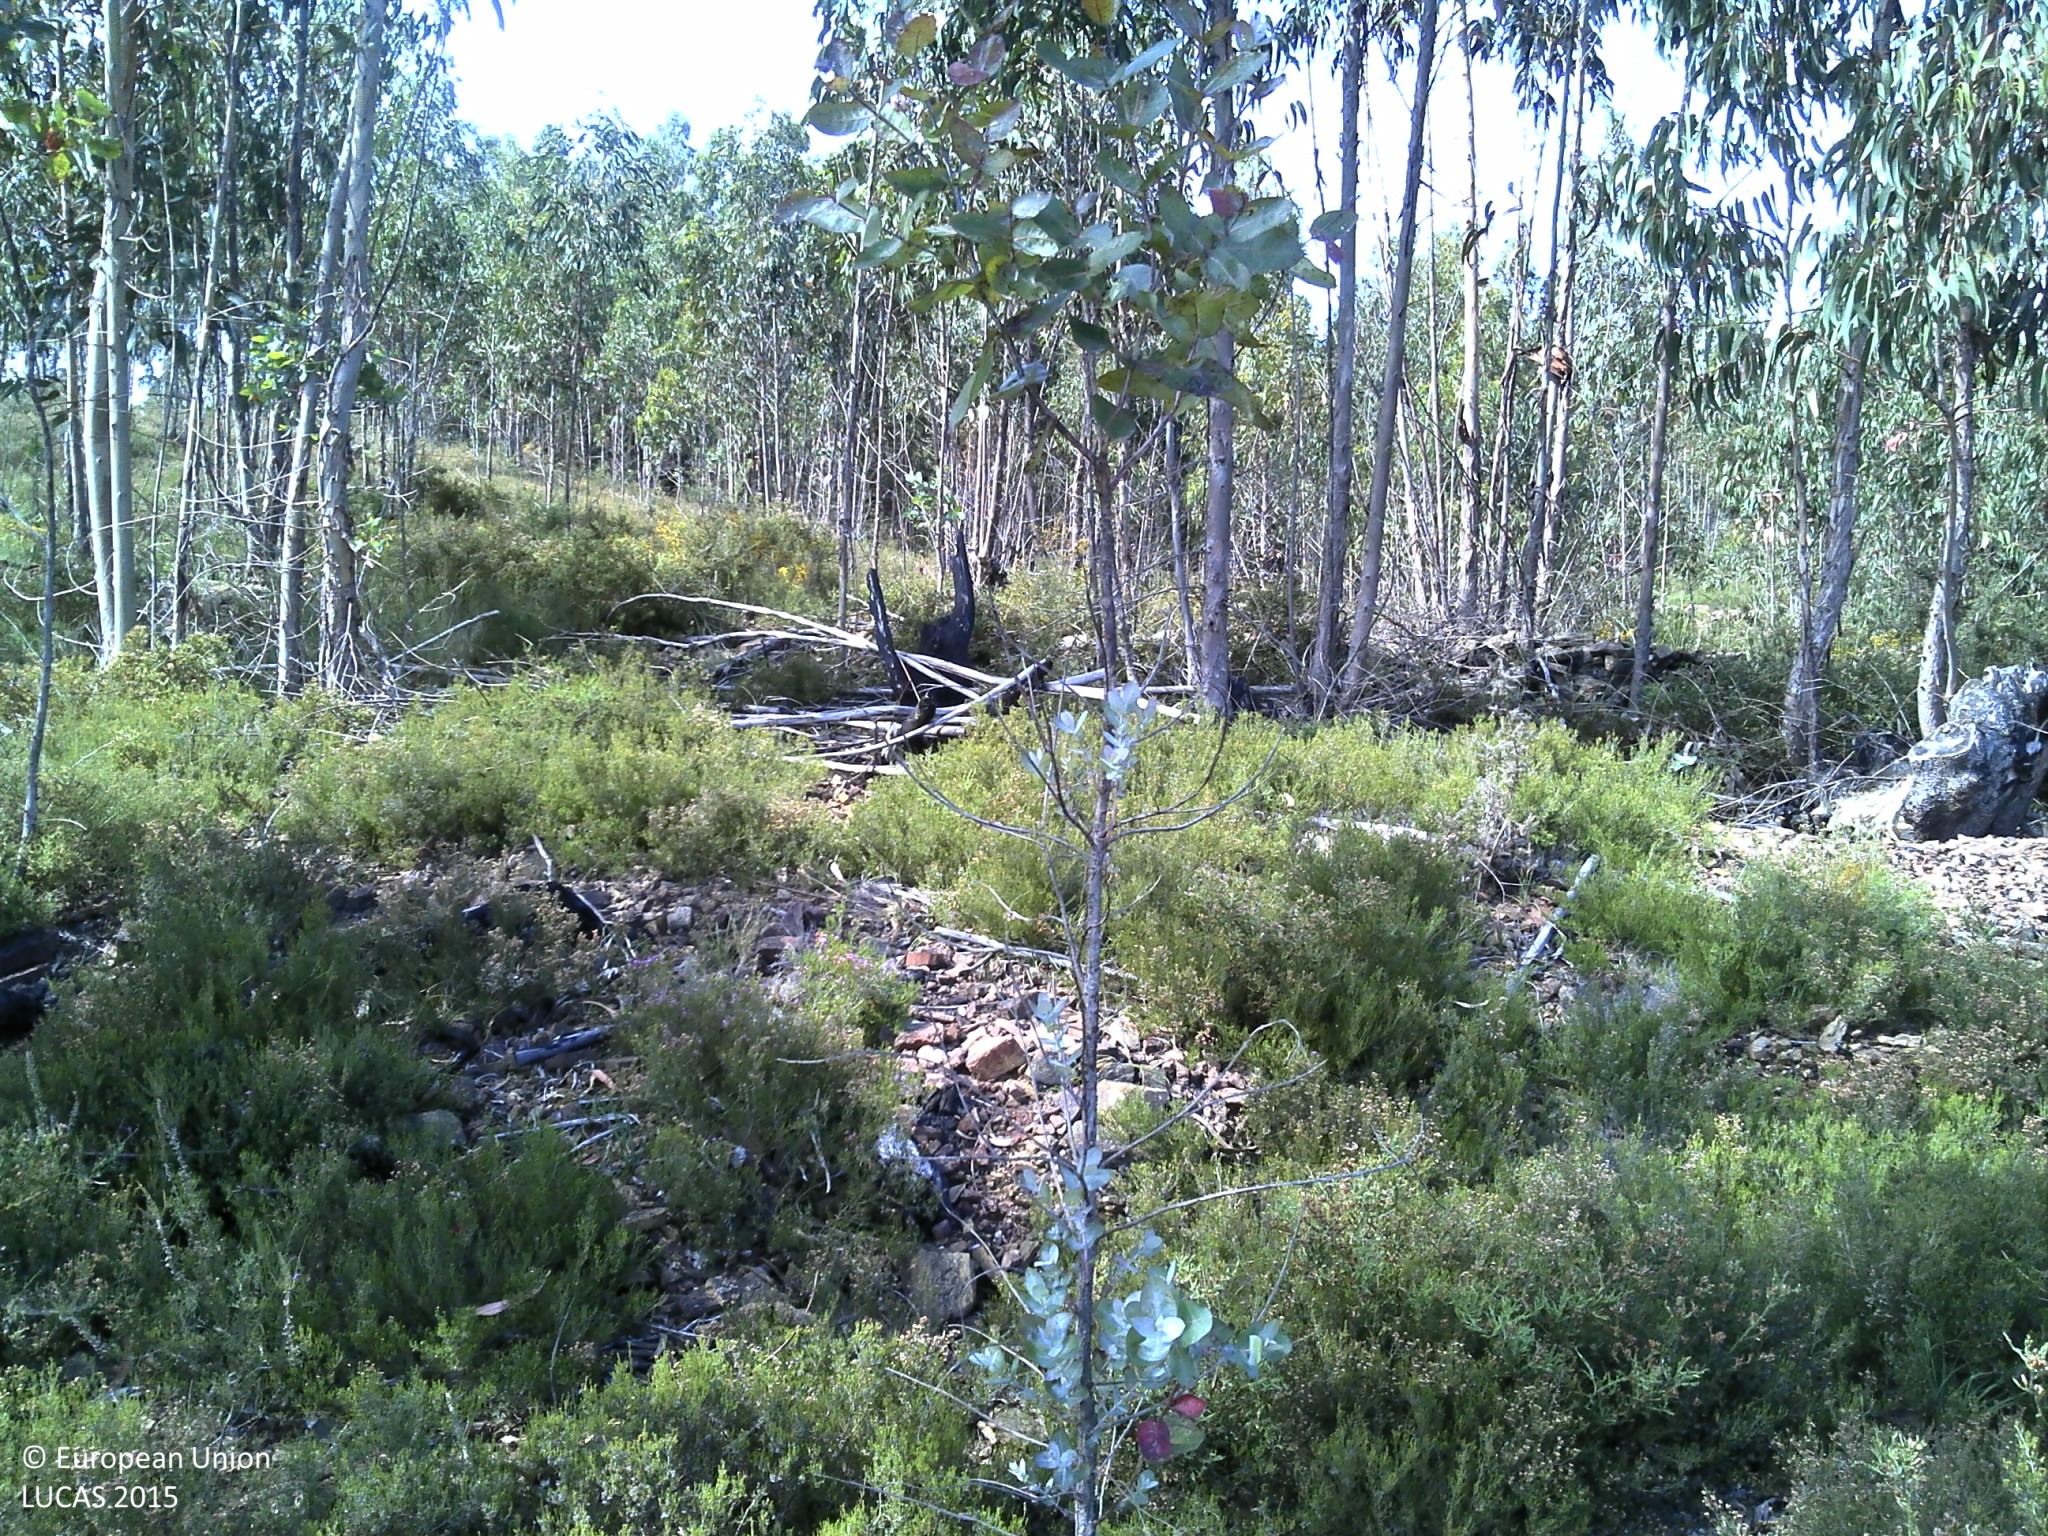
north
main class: Shrubland
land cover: Shrubland with sparse tree cover
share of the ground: 50 - 75 %
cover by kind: shrubs 65 %, consolidated bare surface 15 %, unconsolidated bare surface 10 %, broadleaved forest trees 5 %, herbaceous plants 5 %
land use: Forestry
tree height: > 5 m
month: May
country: PT
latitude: 41.2696
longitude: -8.4743
